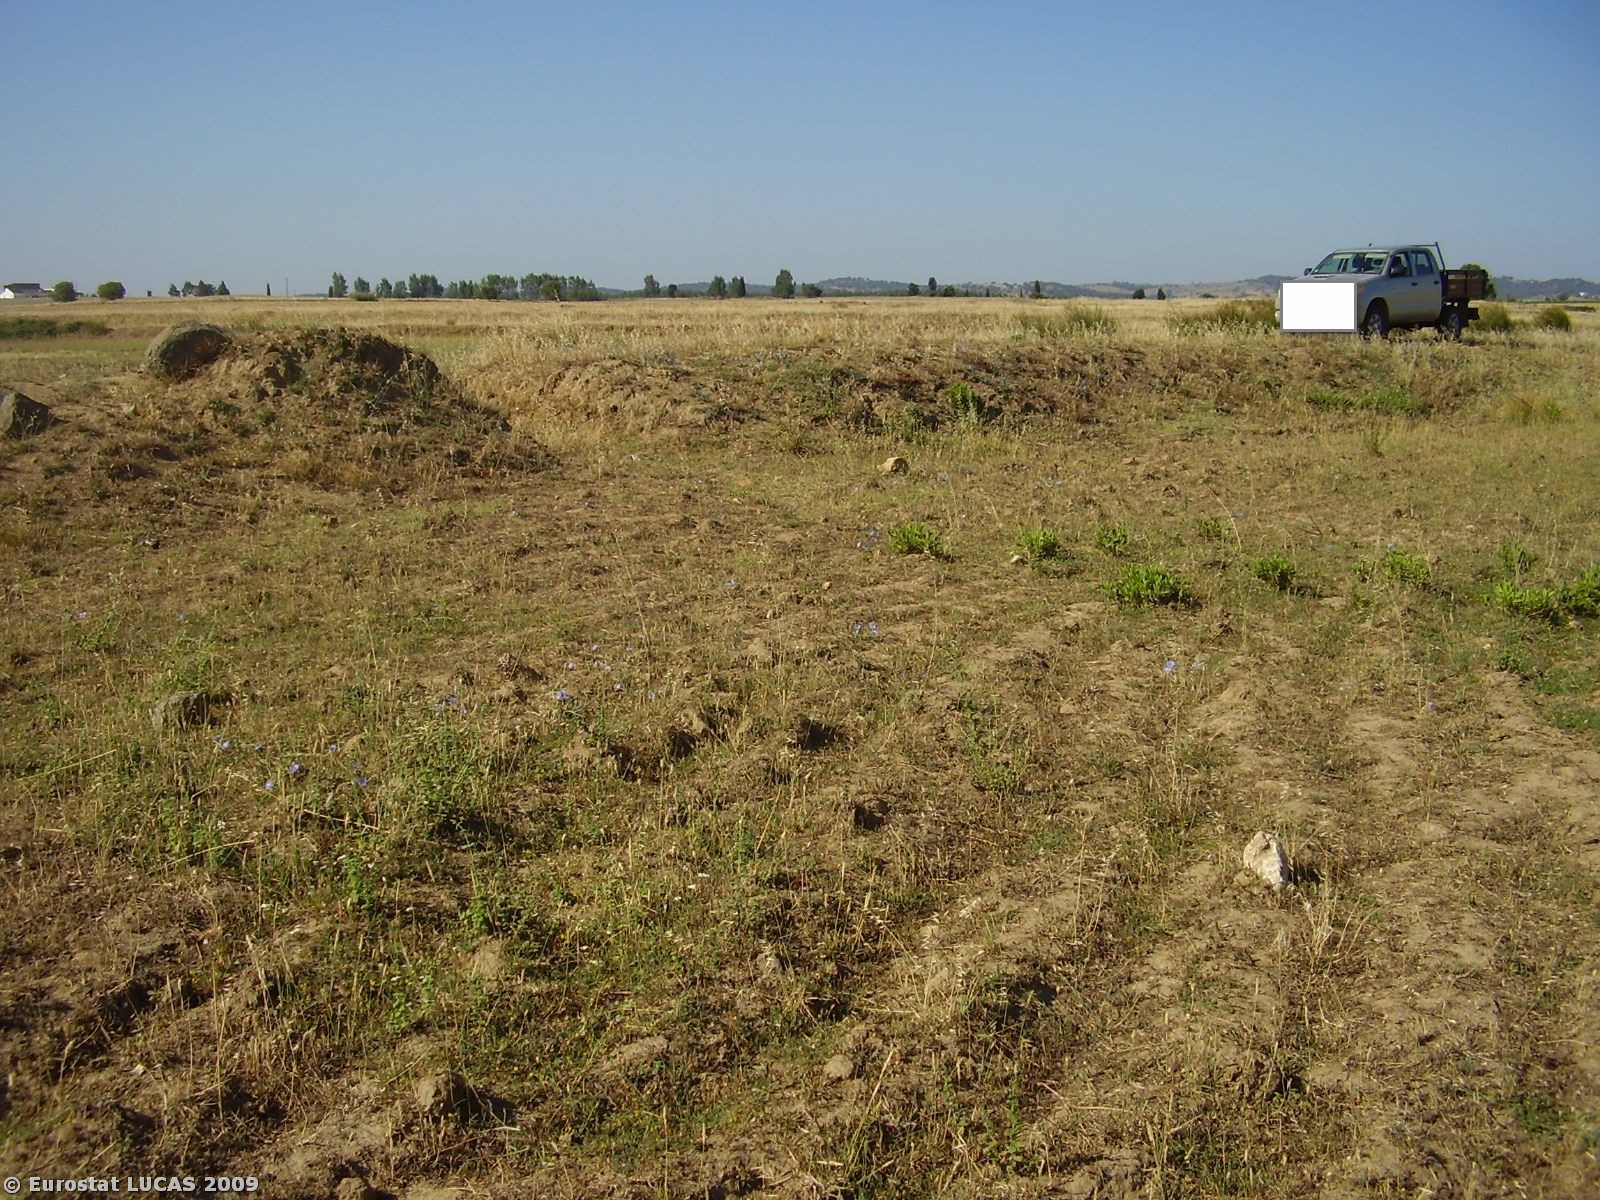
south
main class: Grassland
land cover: Spontaneously vegetated surfaces
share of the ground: > 75 %
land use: Fallow land
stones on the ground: 10 - 25 %
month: July
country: PT
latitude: 38.7471
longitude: -7.9351
